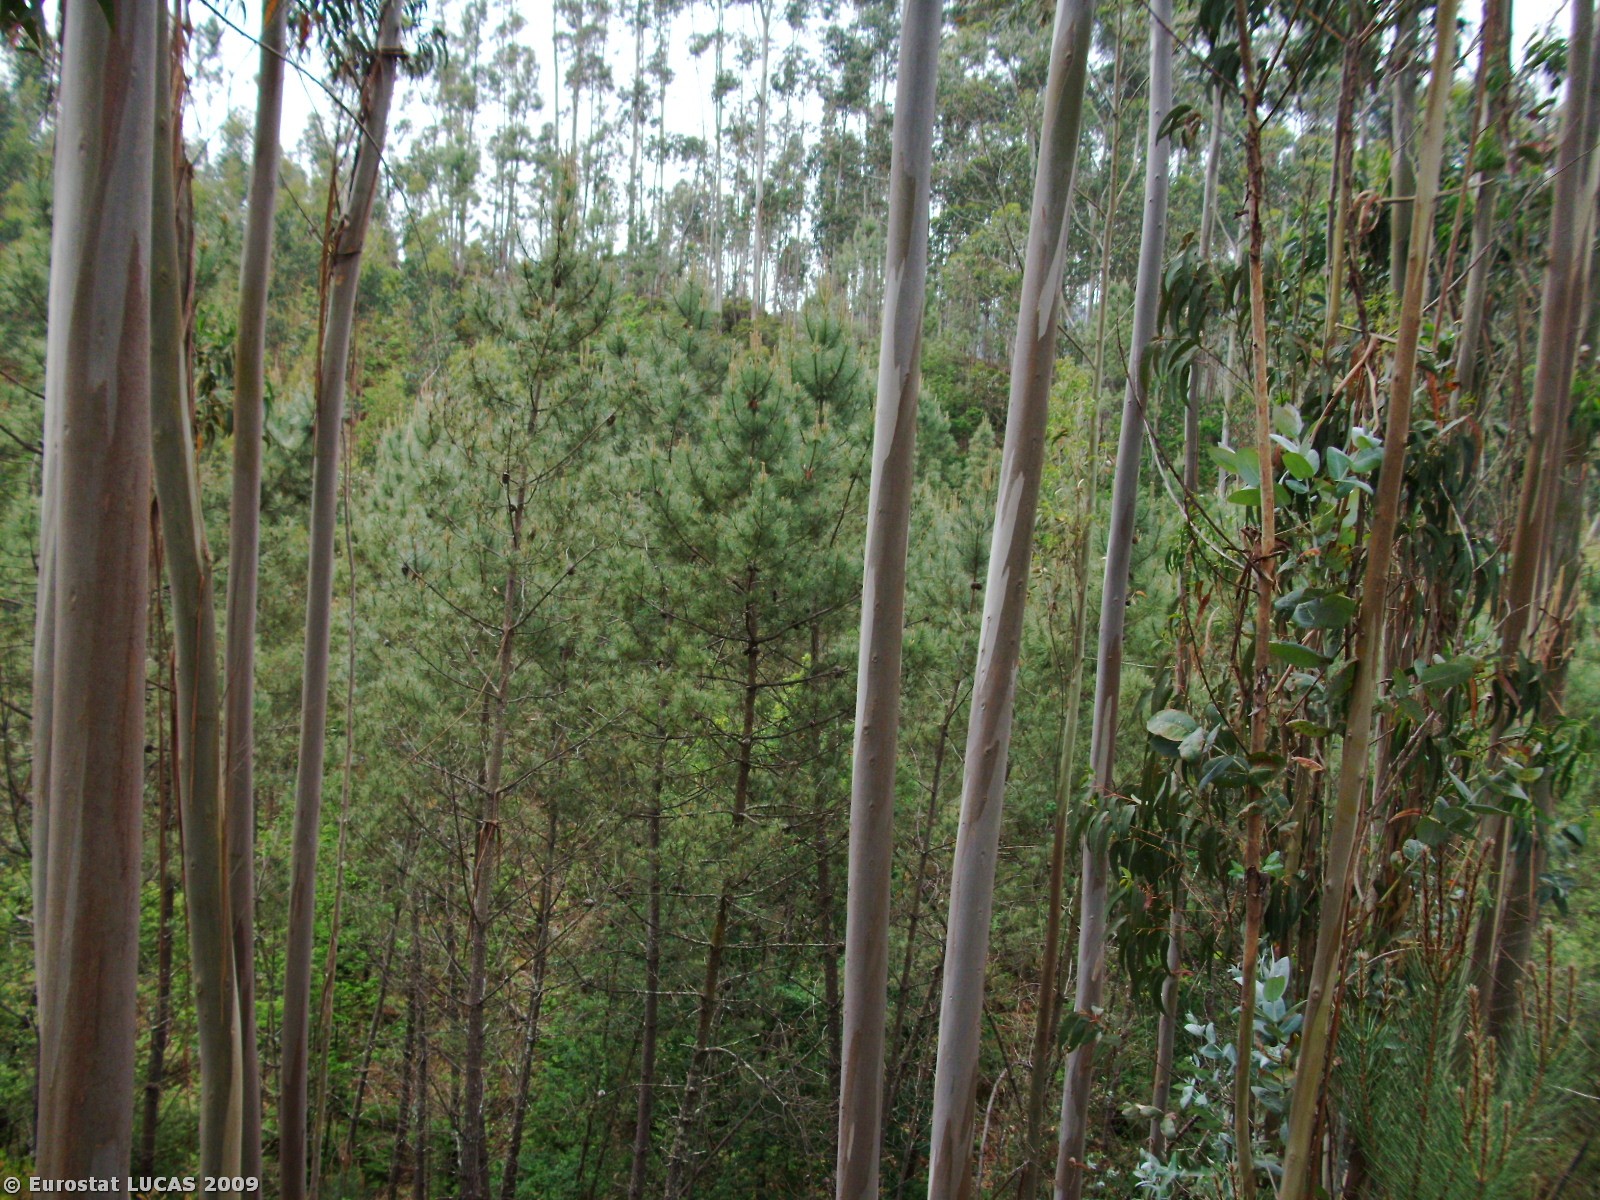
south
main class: Woodland
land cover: Broadleaved woodland
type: plantations and self-sown exotic forest
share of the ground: > 75 %
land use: Forestry
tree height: > 5 m
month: May
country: PT
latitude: 40.3558
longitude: -8.3220
